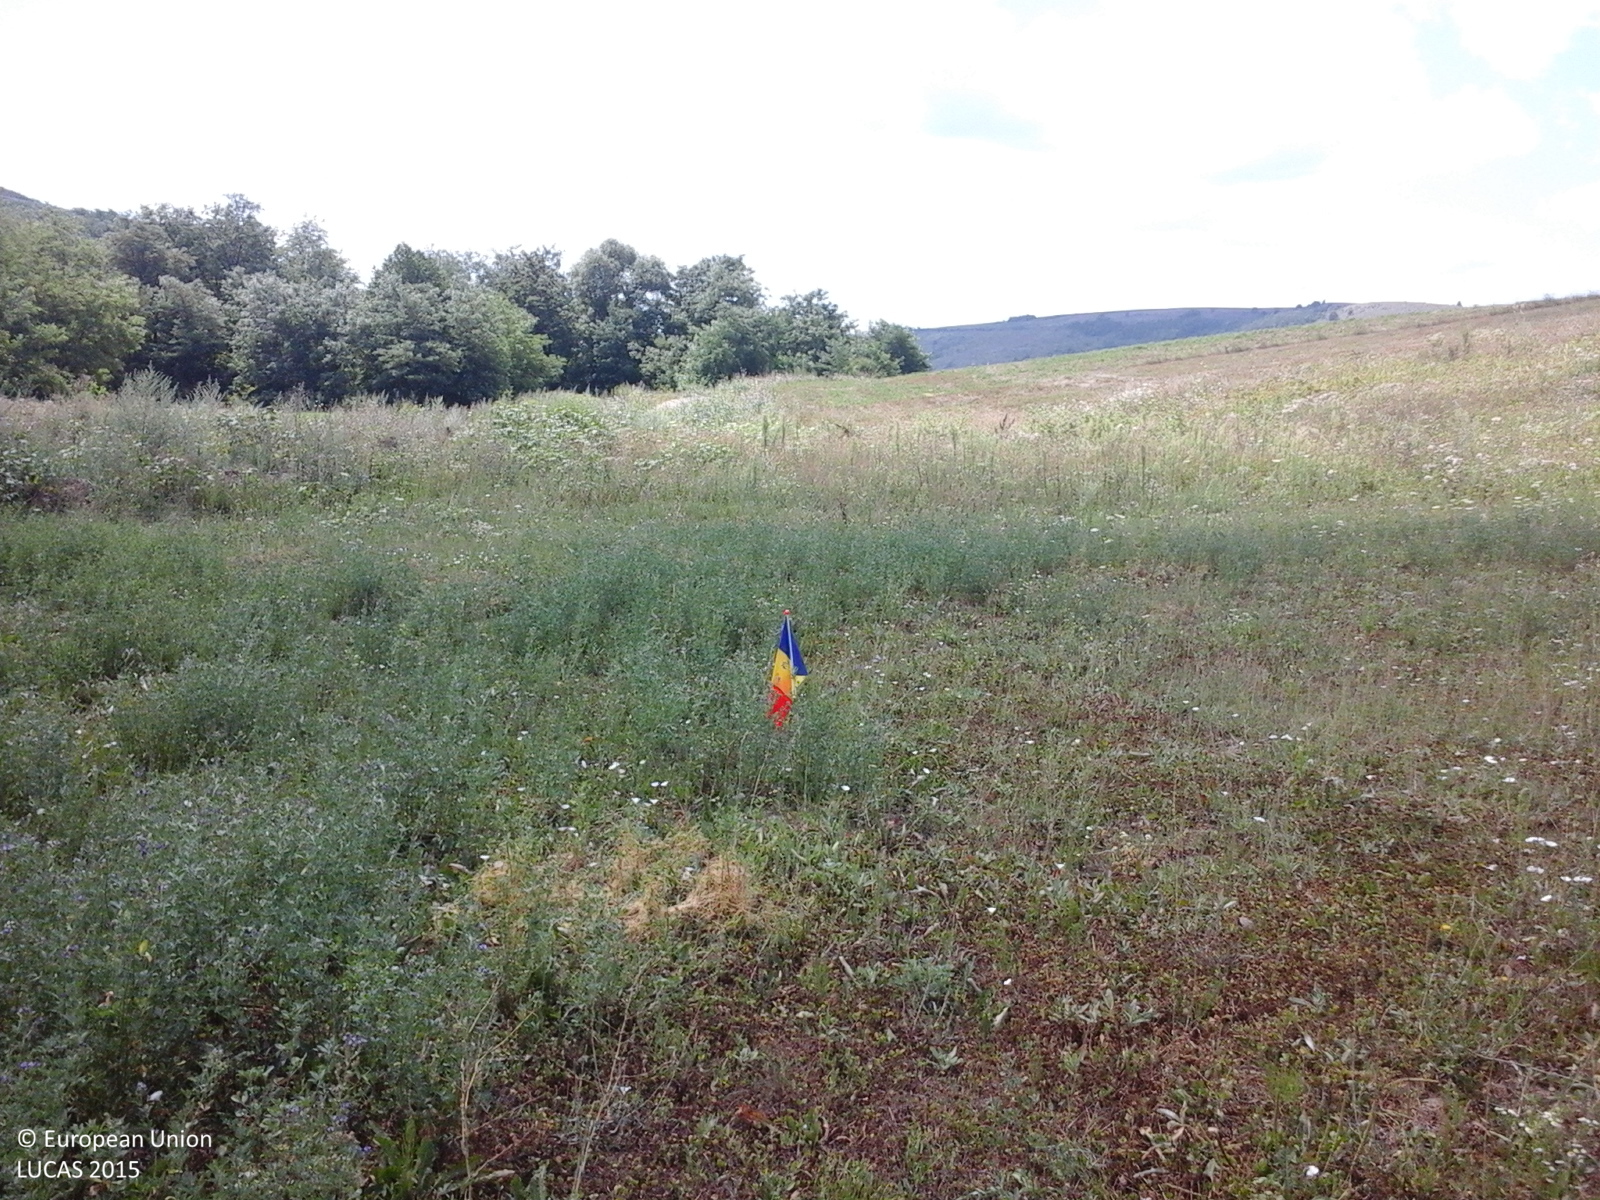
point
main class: Cropland
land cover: Lucerne
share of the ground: > 75 %
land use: Agriculture (excluding fallow land and kitchen gardens)
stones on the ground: < 10 %
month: July
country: RO
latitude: 46.5761
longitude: 27.2360
